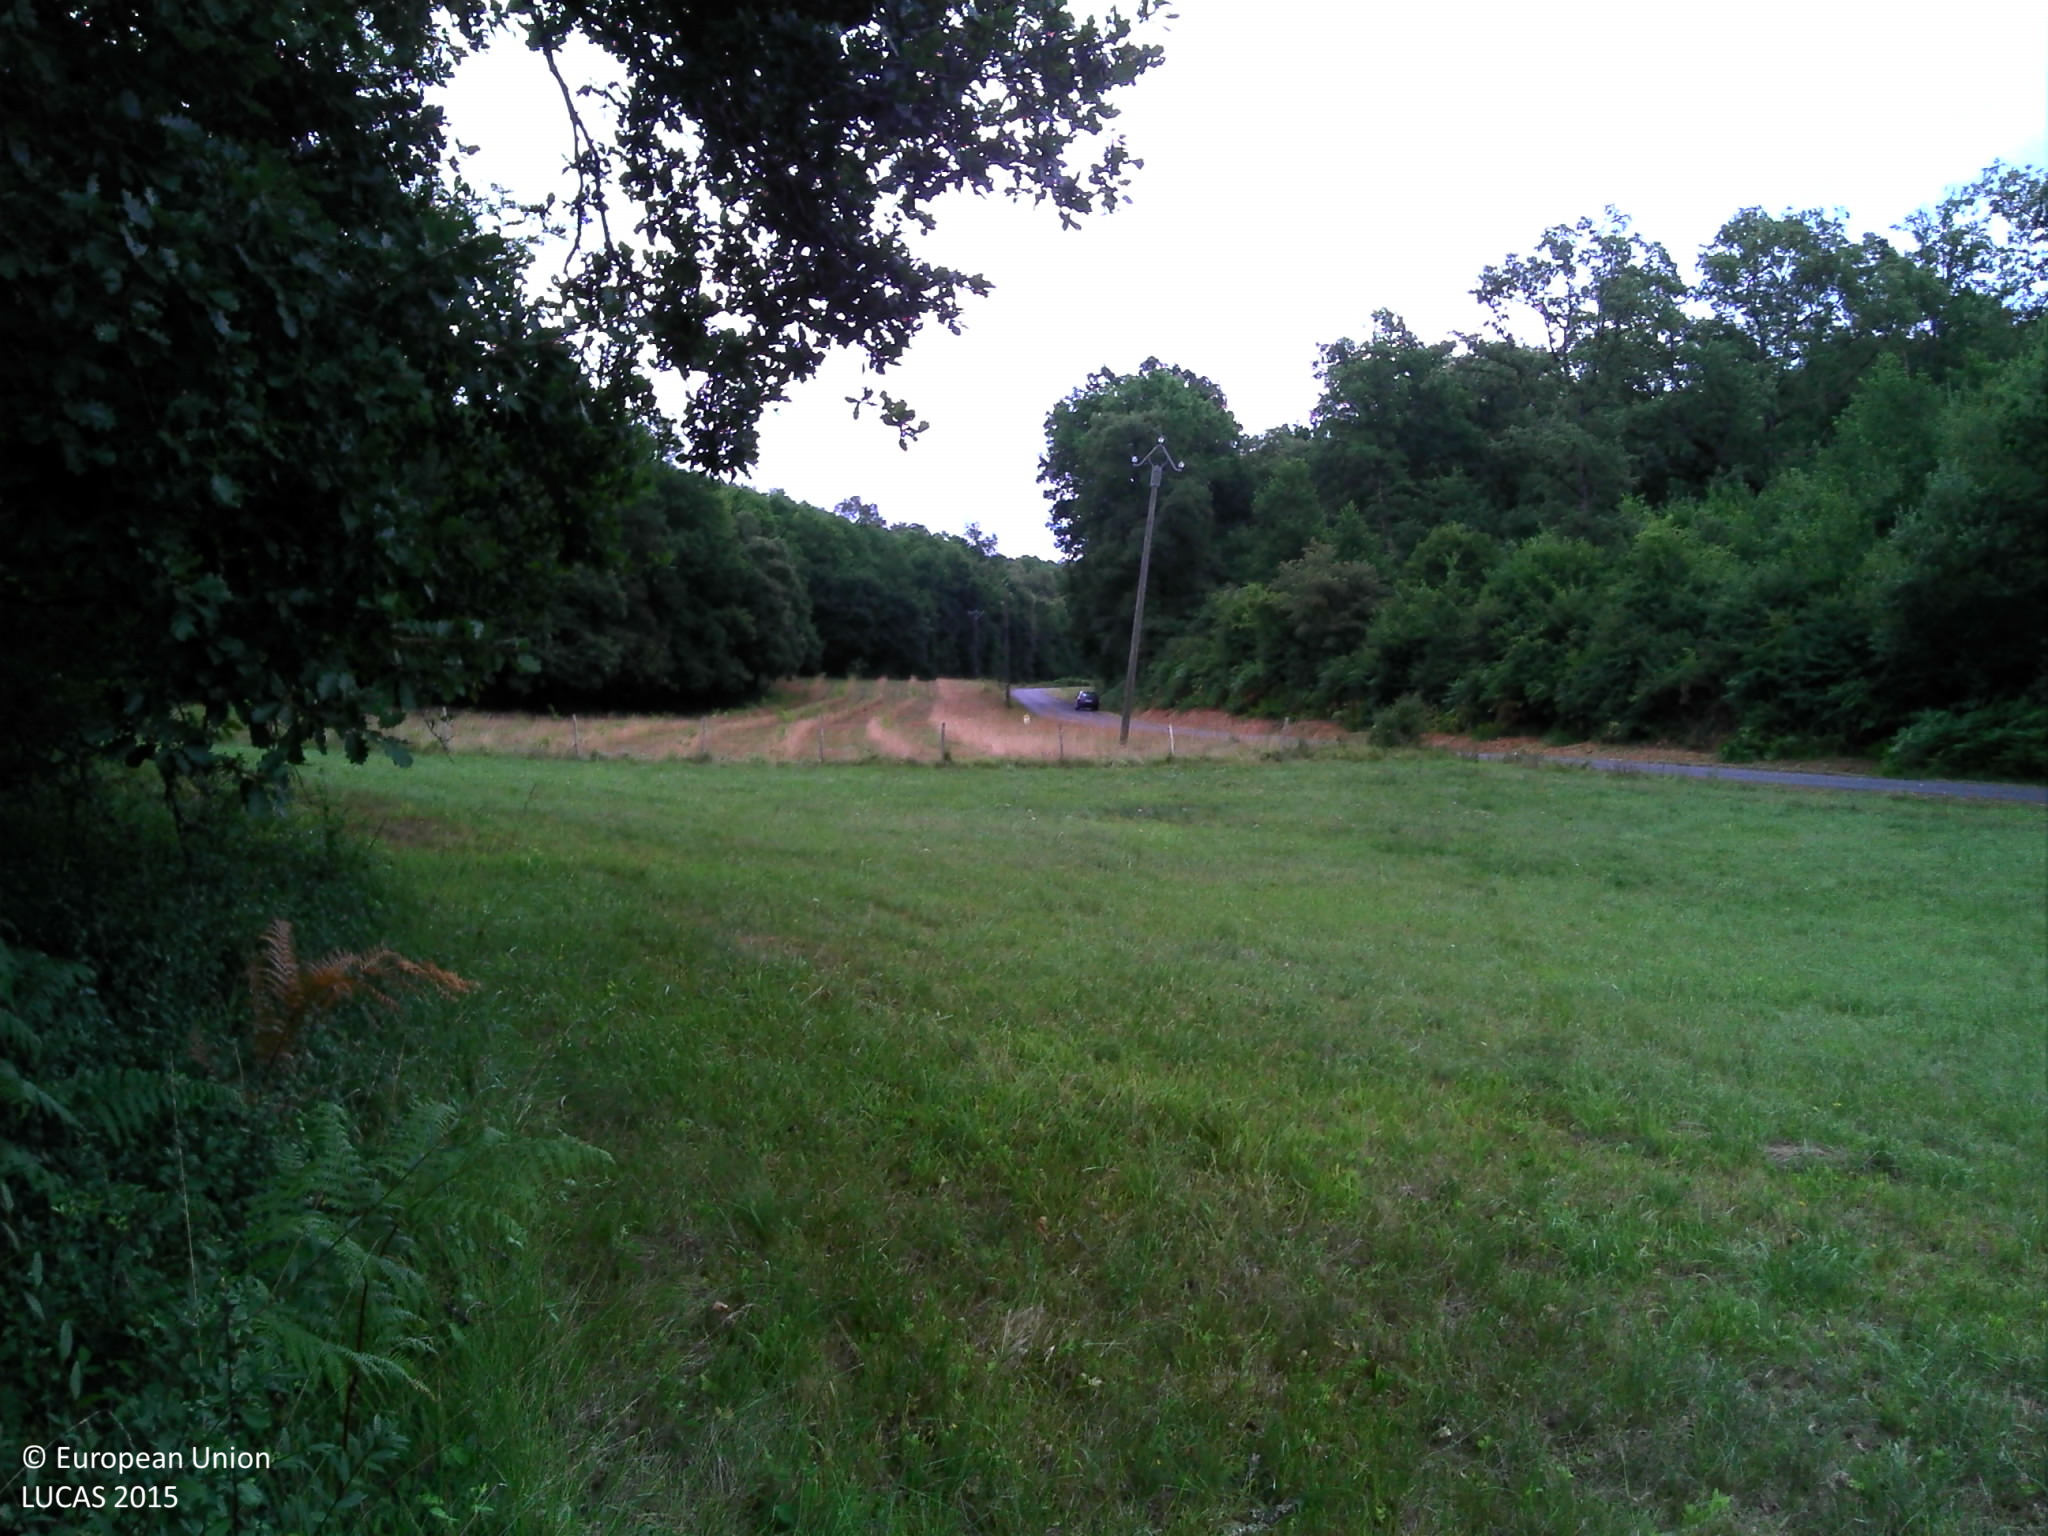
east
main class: Woodland
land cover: Broadleaved woodland
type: acidophilous oak and oak-birch forest
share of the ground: > 75 %
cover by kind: broadleaved forest trees 65 %, herbaceous plants 20 %, shrubs 15 %
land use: Forestry
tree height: > 5 m
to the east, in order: Broadleaved woodland; Grassland without tree/shrub cover; Fences; Grassland without tree/shrub cover; Tracks
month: July
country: FR
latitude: 45.0464
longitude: 0.7866
